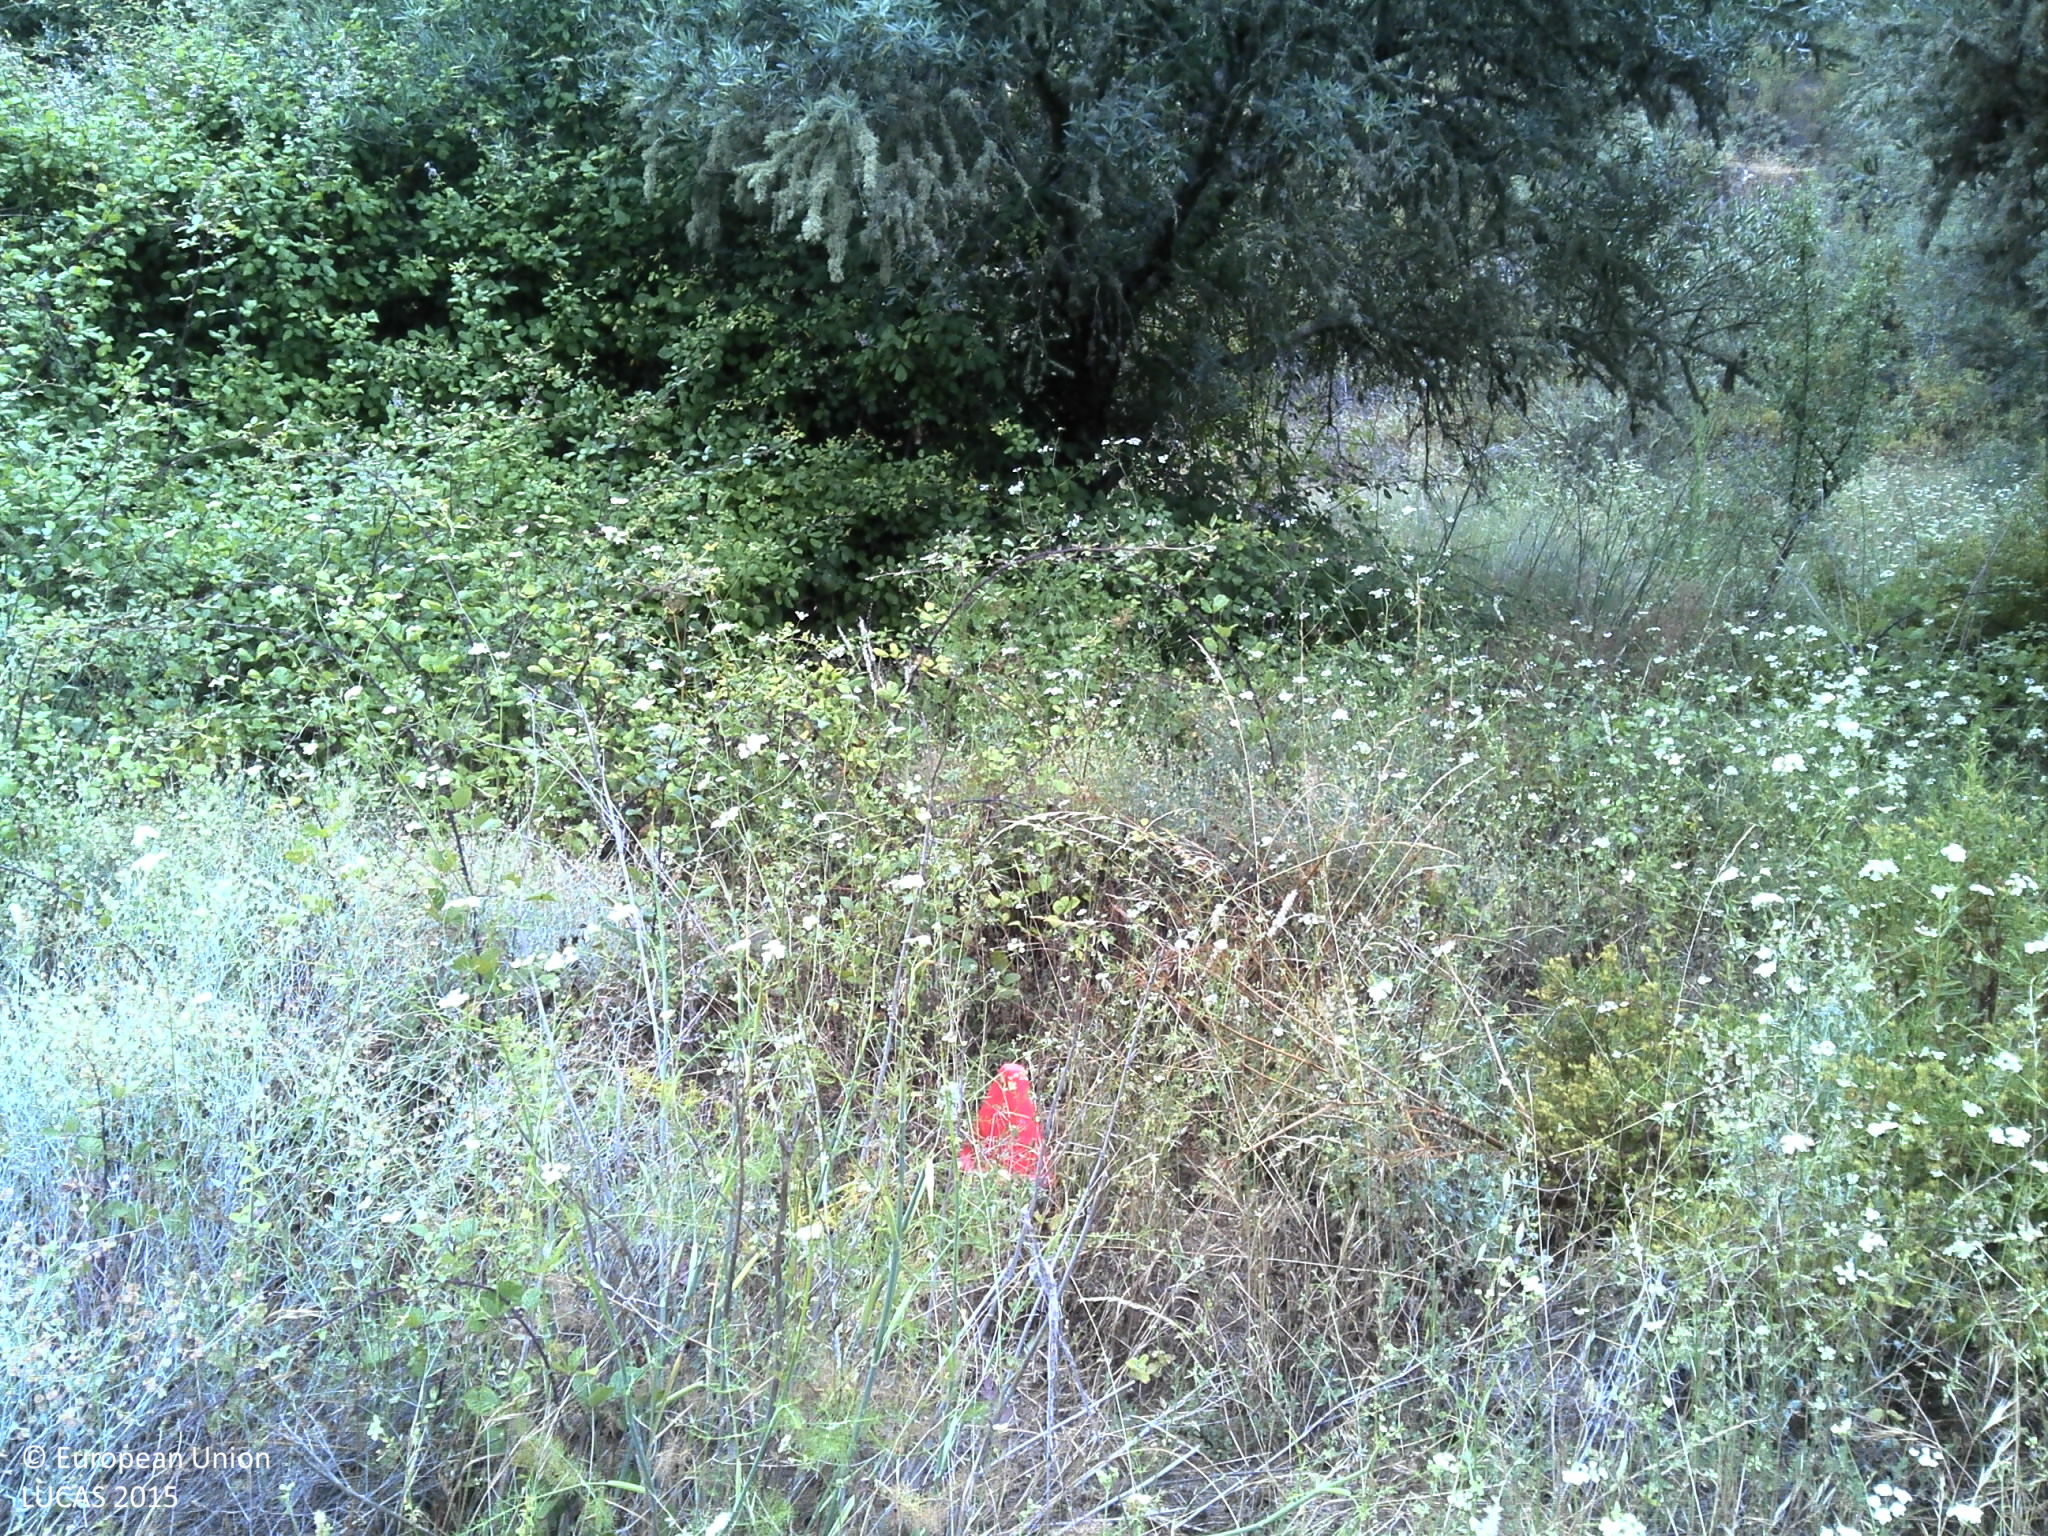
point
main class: Cropland
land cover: Olive groves
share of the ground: 25 - 50 %
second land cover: Shrubland without tree cover
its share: 50 - 75 %
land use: Agriculture (excluding fallow land and kitchen gardens)
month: June
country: PT
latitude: 37.3462
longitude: -7.8148
